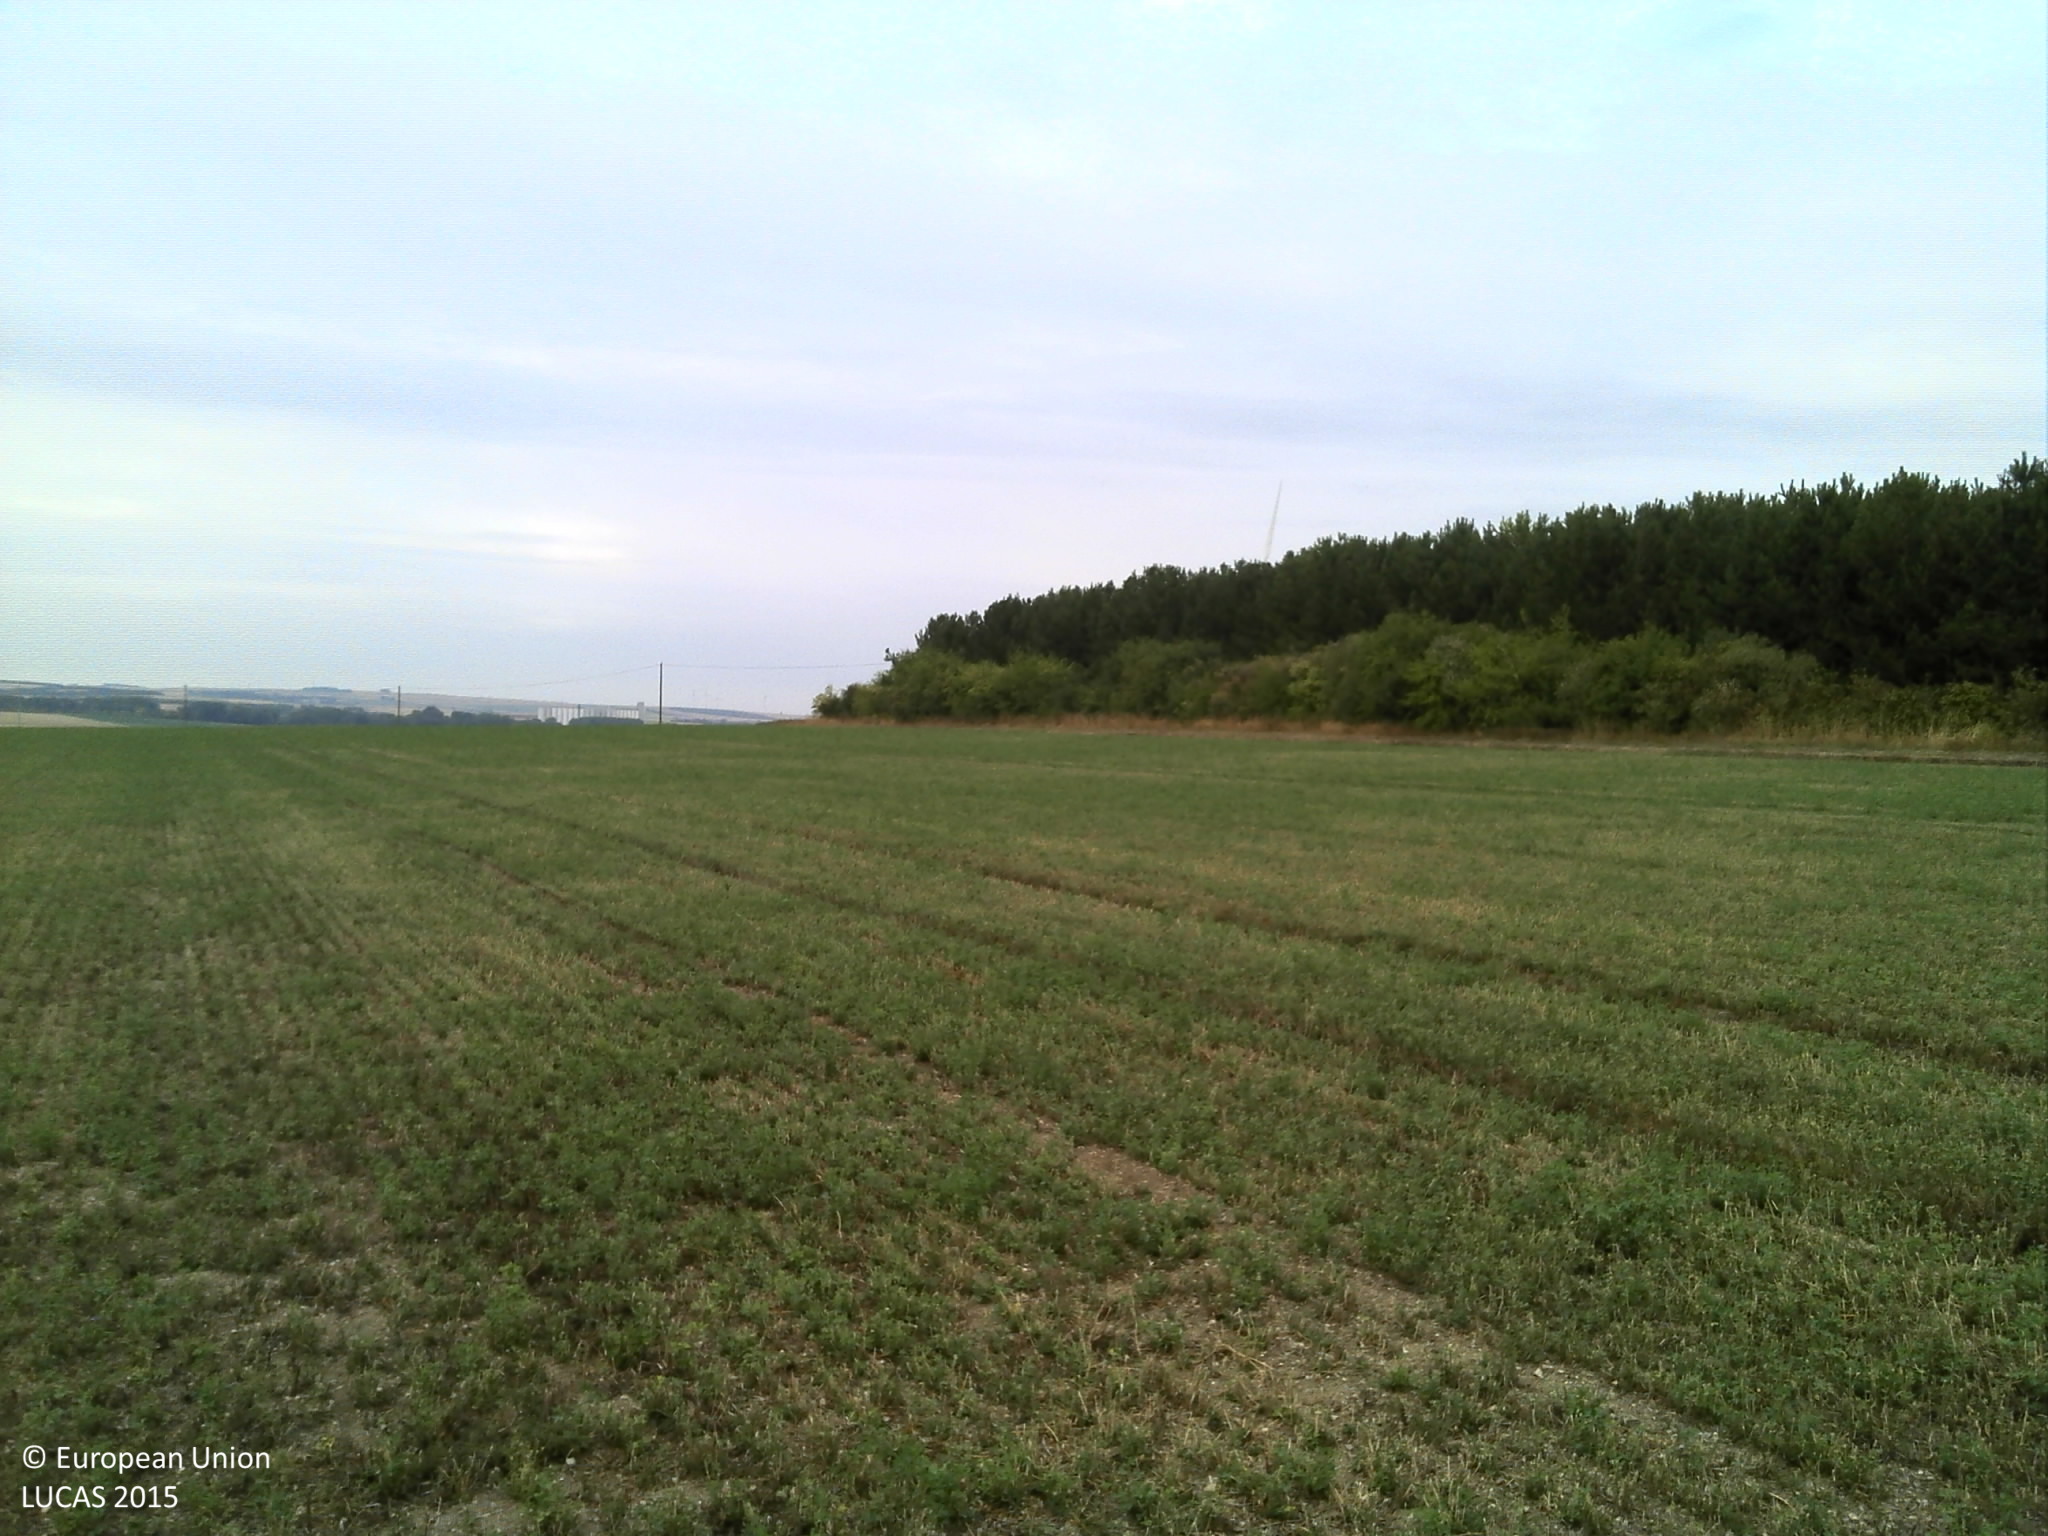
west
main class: Cropland
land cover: Lucerne
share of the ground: > 75 %
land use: Agriculture (excluding fallow land and kitchen gardens)
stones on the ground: 10 - 25 %
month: August
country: FR
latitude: 48.4316
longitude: 4.1983
